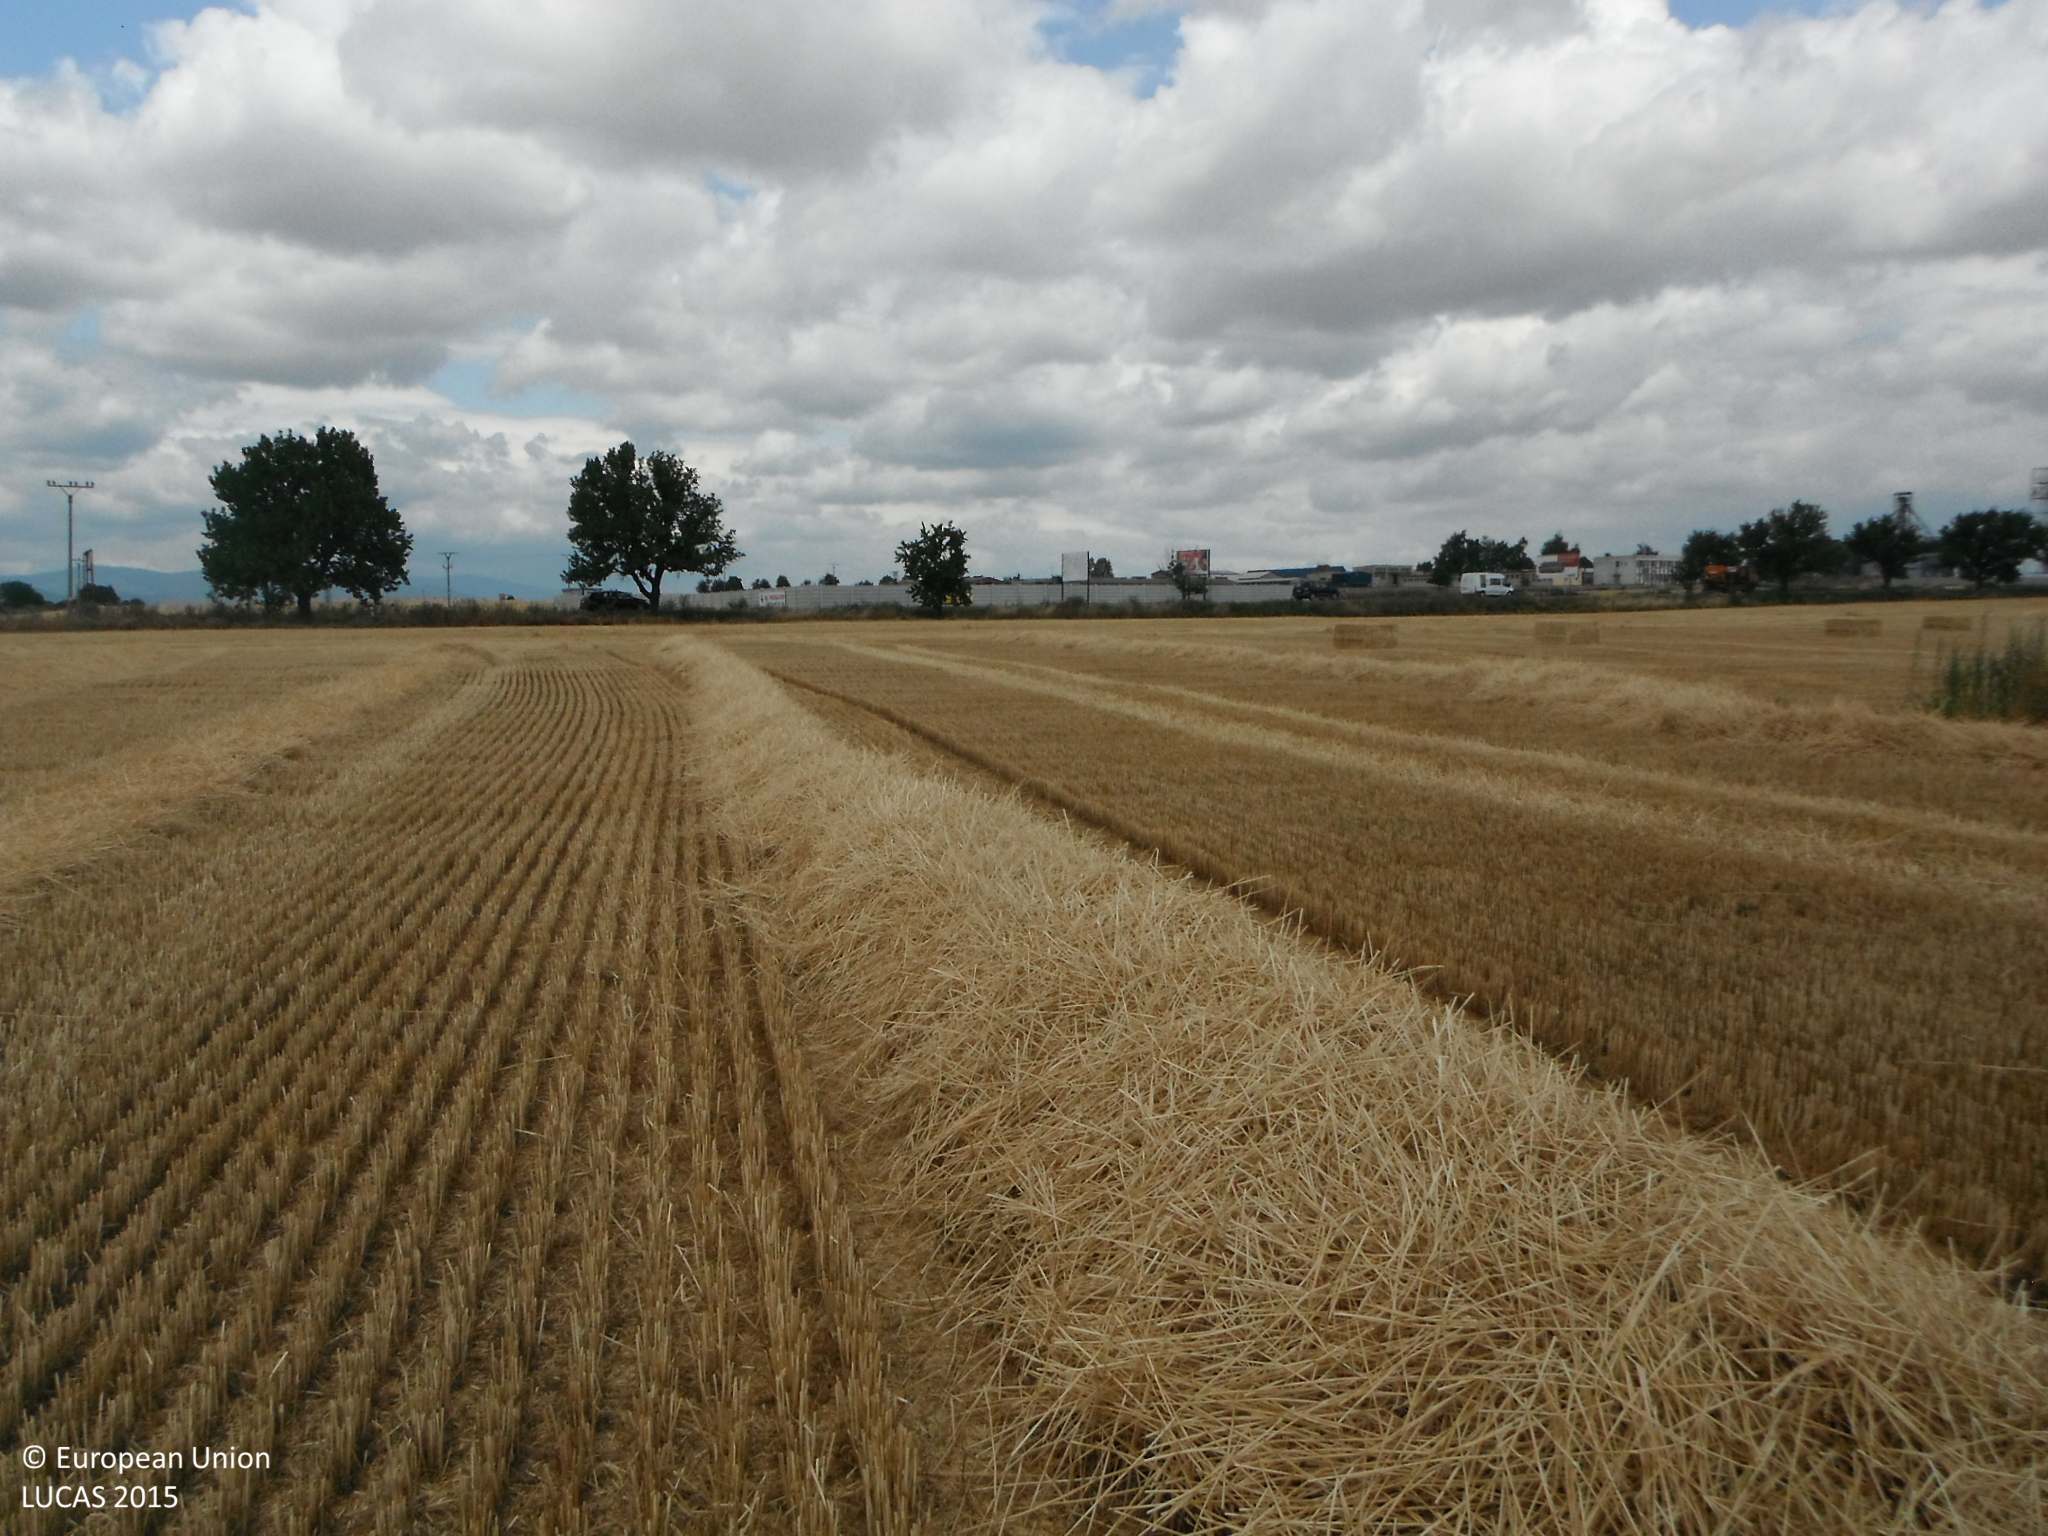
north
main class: Cropland
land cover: Common wheat
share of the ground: > 75 %
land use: Agriculture (excluding fallow land and kitchen gardens)
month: July
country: SK
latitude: 48.5558
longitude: 18.1301
